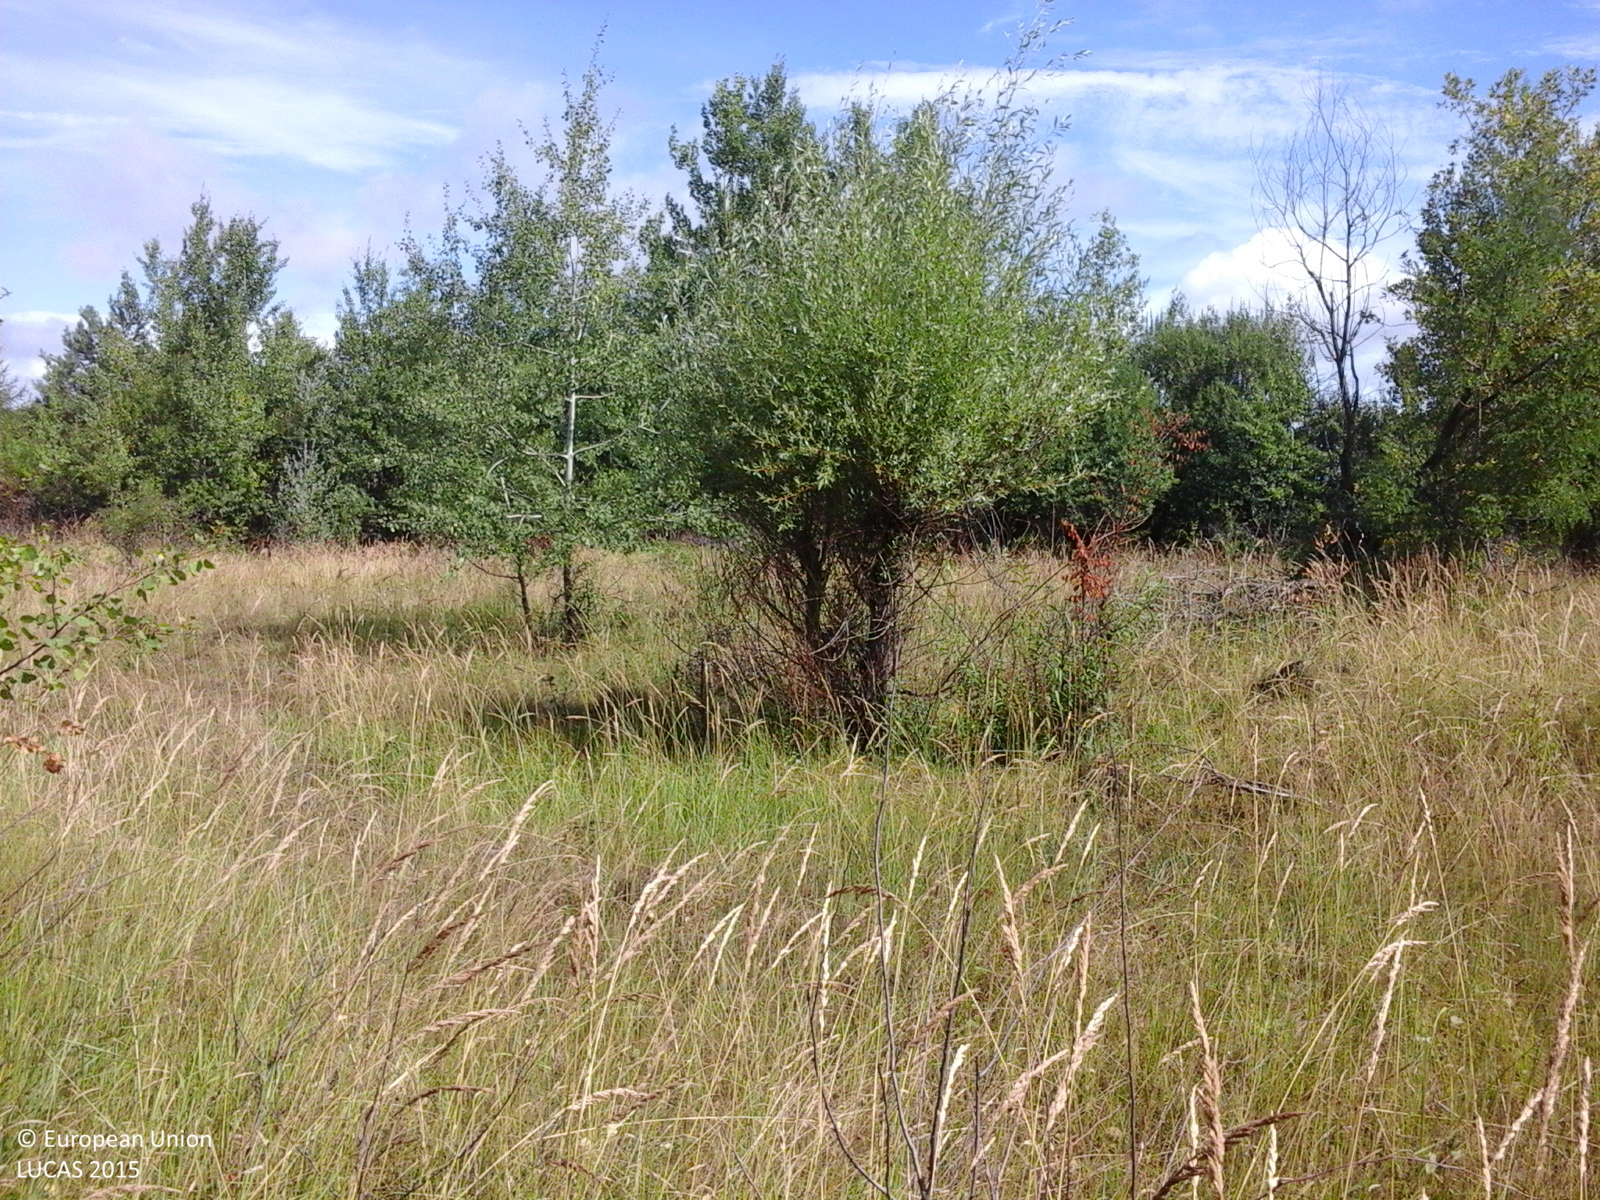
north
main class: Woodland
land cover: Broadleaved woodland
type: beech forest
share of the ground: > 75 %
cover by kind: broadleaved forest trees 100 %
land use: Forestry
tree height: > 5 m
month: August
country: RO
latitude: 45.0552
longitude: 21.8300
